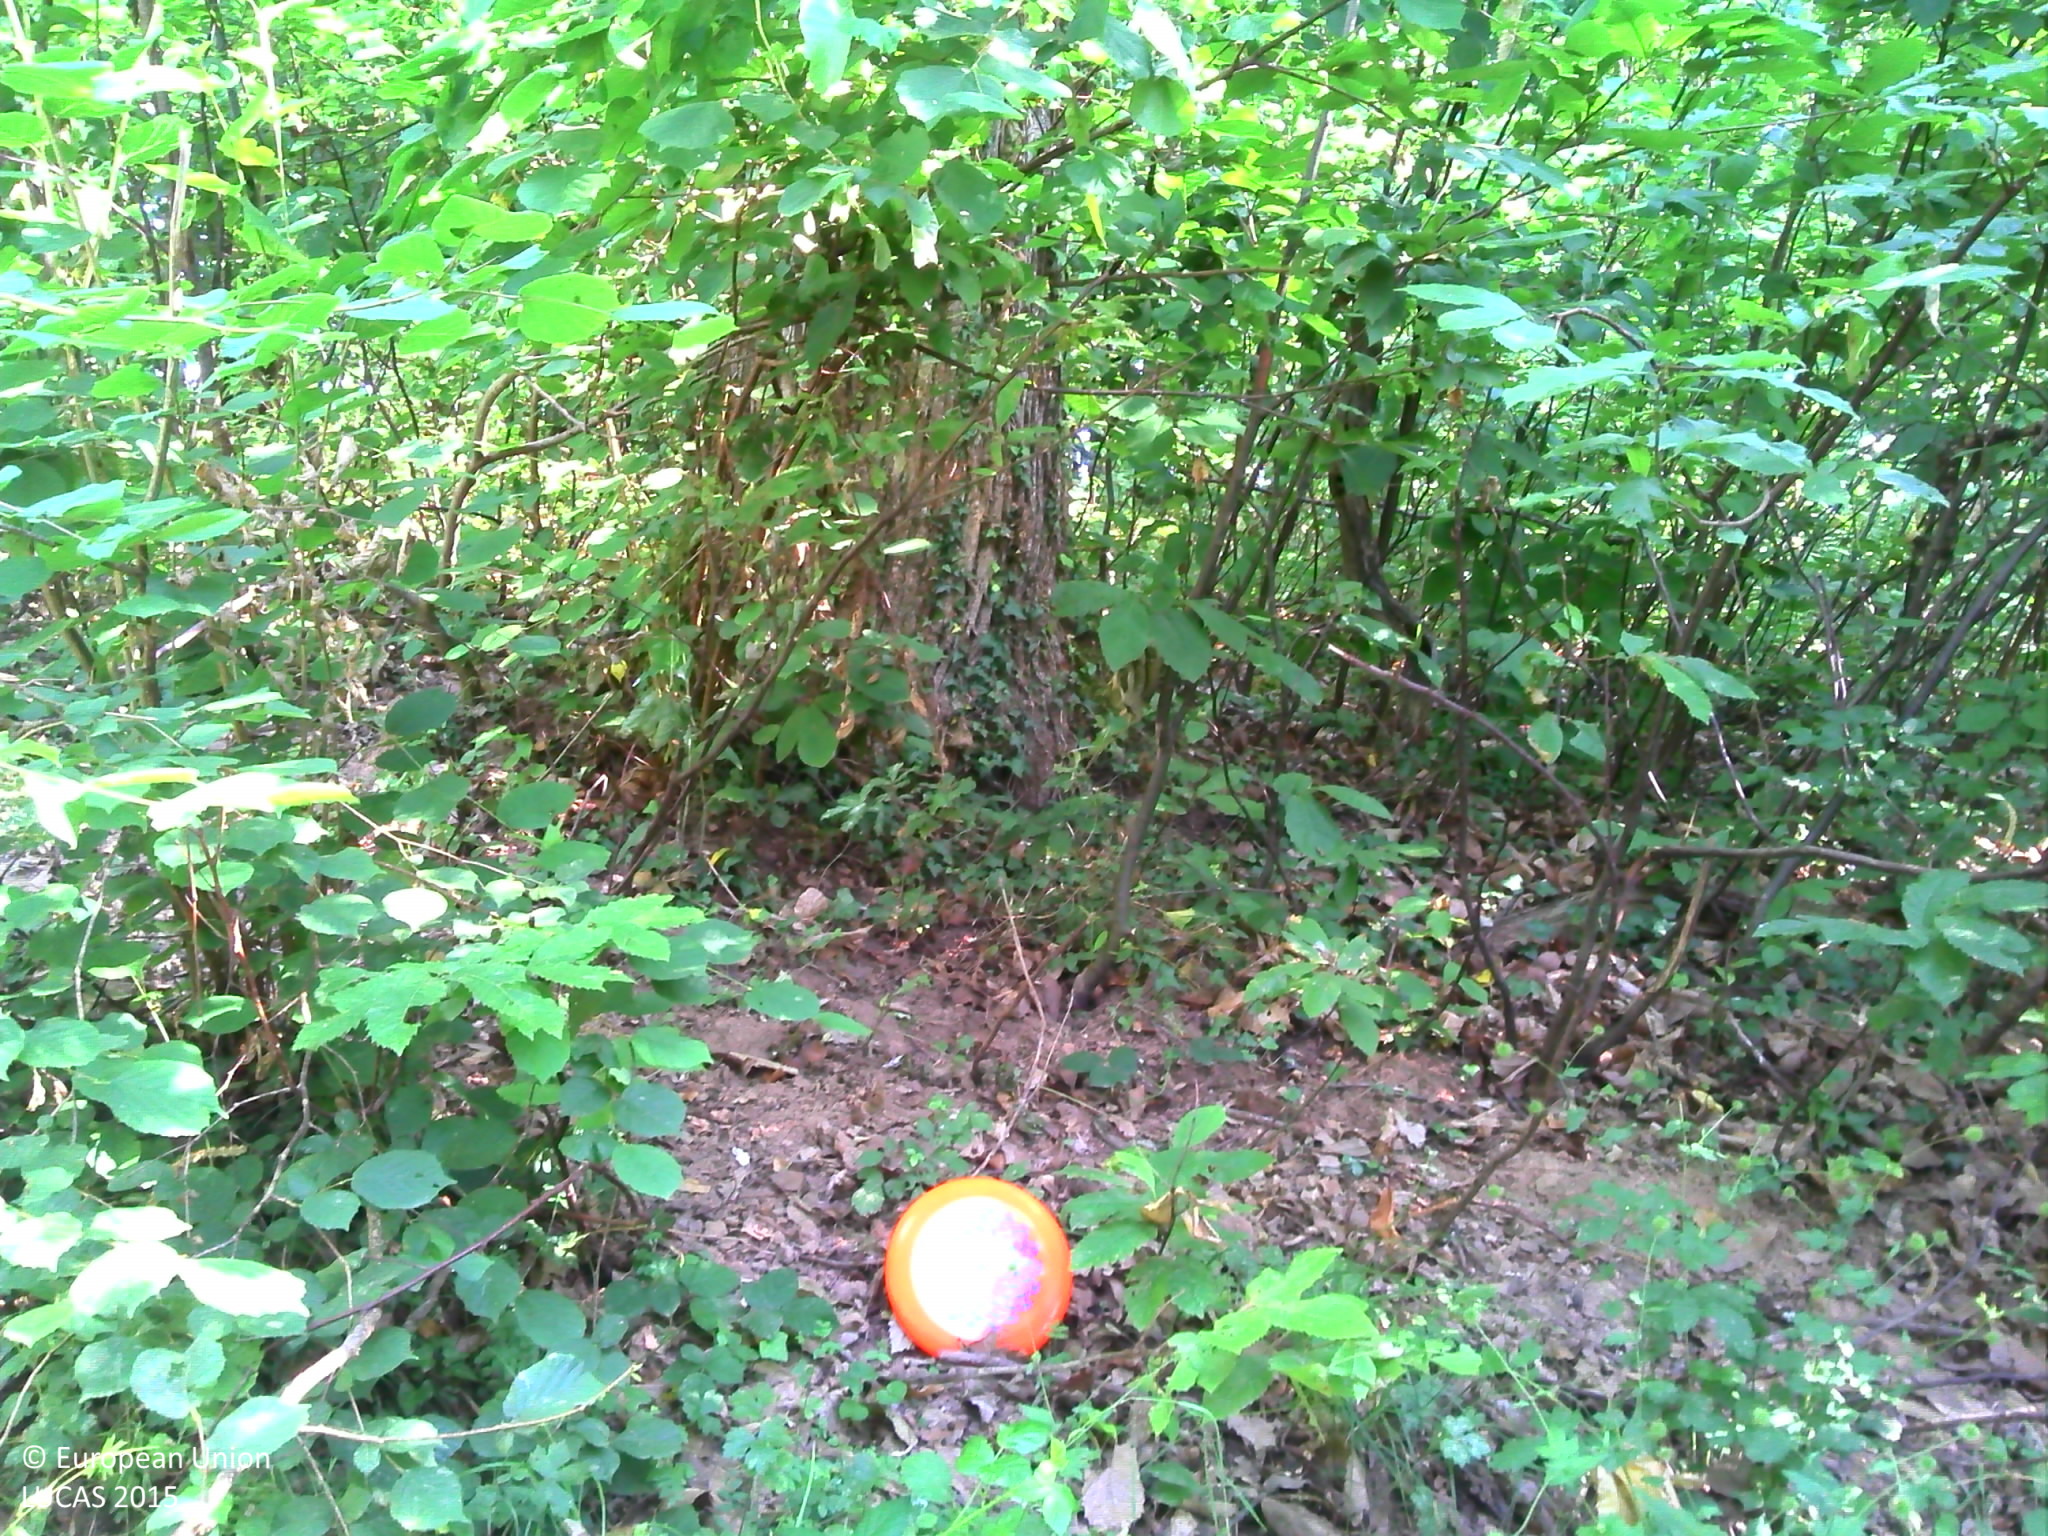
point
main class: Woodland
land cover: Broadleaved woodland
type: thermophilous deciduous forest
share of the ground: > 75 %
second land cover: Spontaneously vegetated surfaces
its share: > 75 %
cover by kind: broadleaved forest trees 80 %, herbaceous plants 15 %, shrubs 5 %
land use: Forestry
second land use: Agriculture (excluding fallow land and kitchen gardens)
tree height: > 5 m
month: June
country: FR
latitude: 44.5838
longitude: 0.8881
